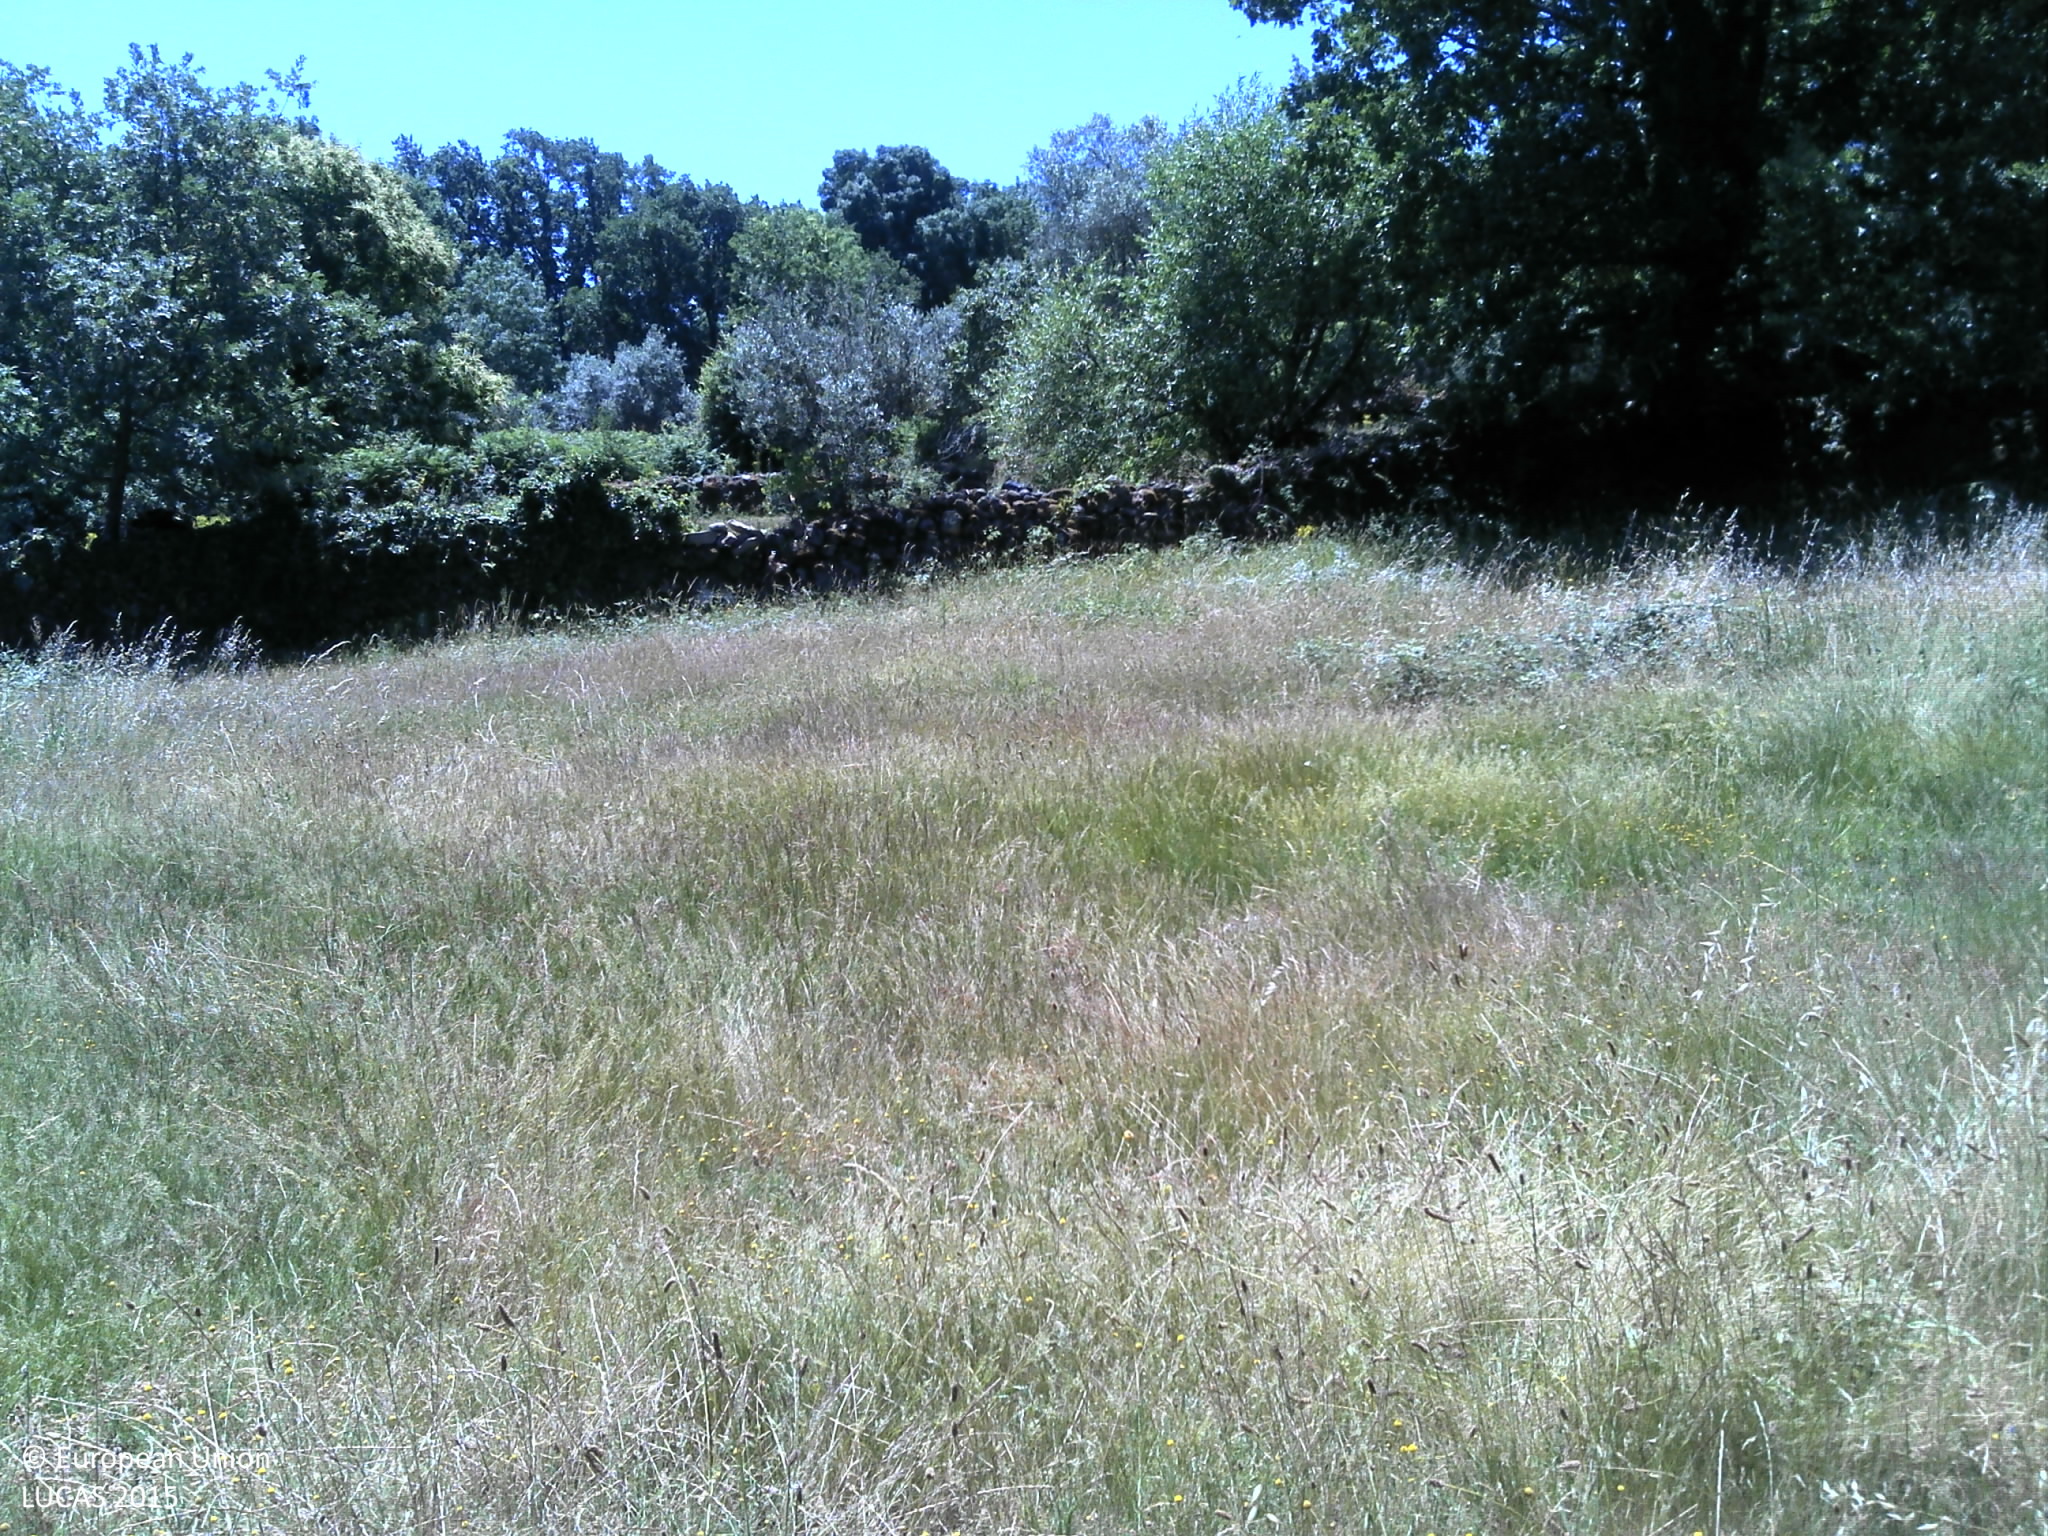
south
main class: Grassland
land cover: Grassland without tree/shrub cover
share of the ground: > 75 %
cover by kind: herbaceous plants 100 %
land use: Agriculture (excluding fallow land and kitchen gardens)
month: June
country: PT
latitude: 40.7515
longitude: -7.2716
